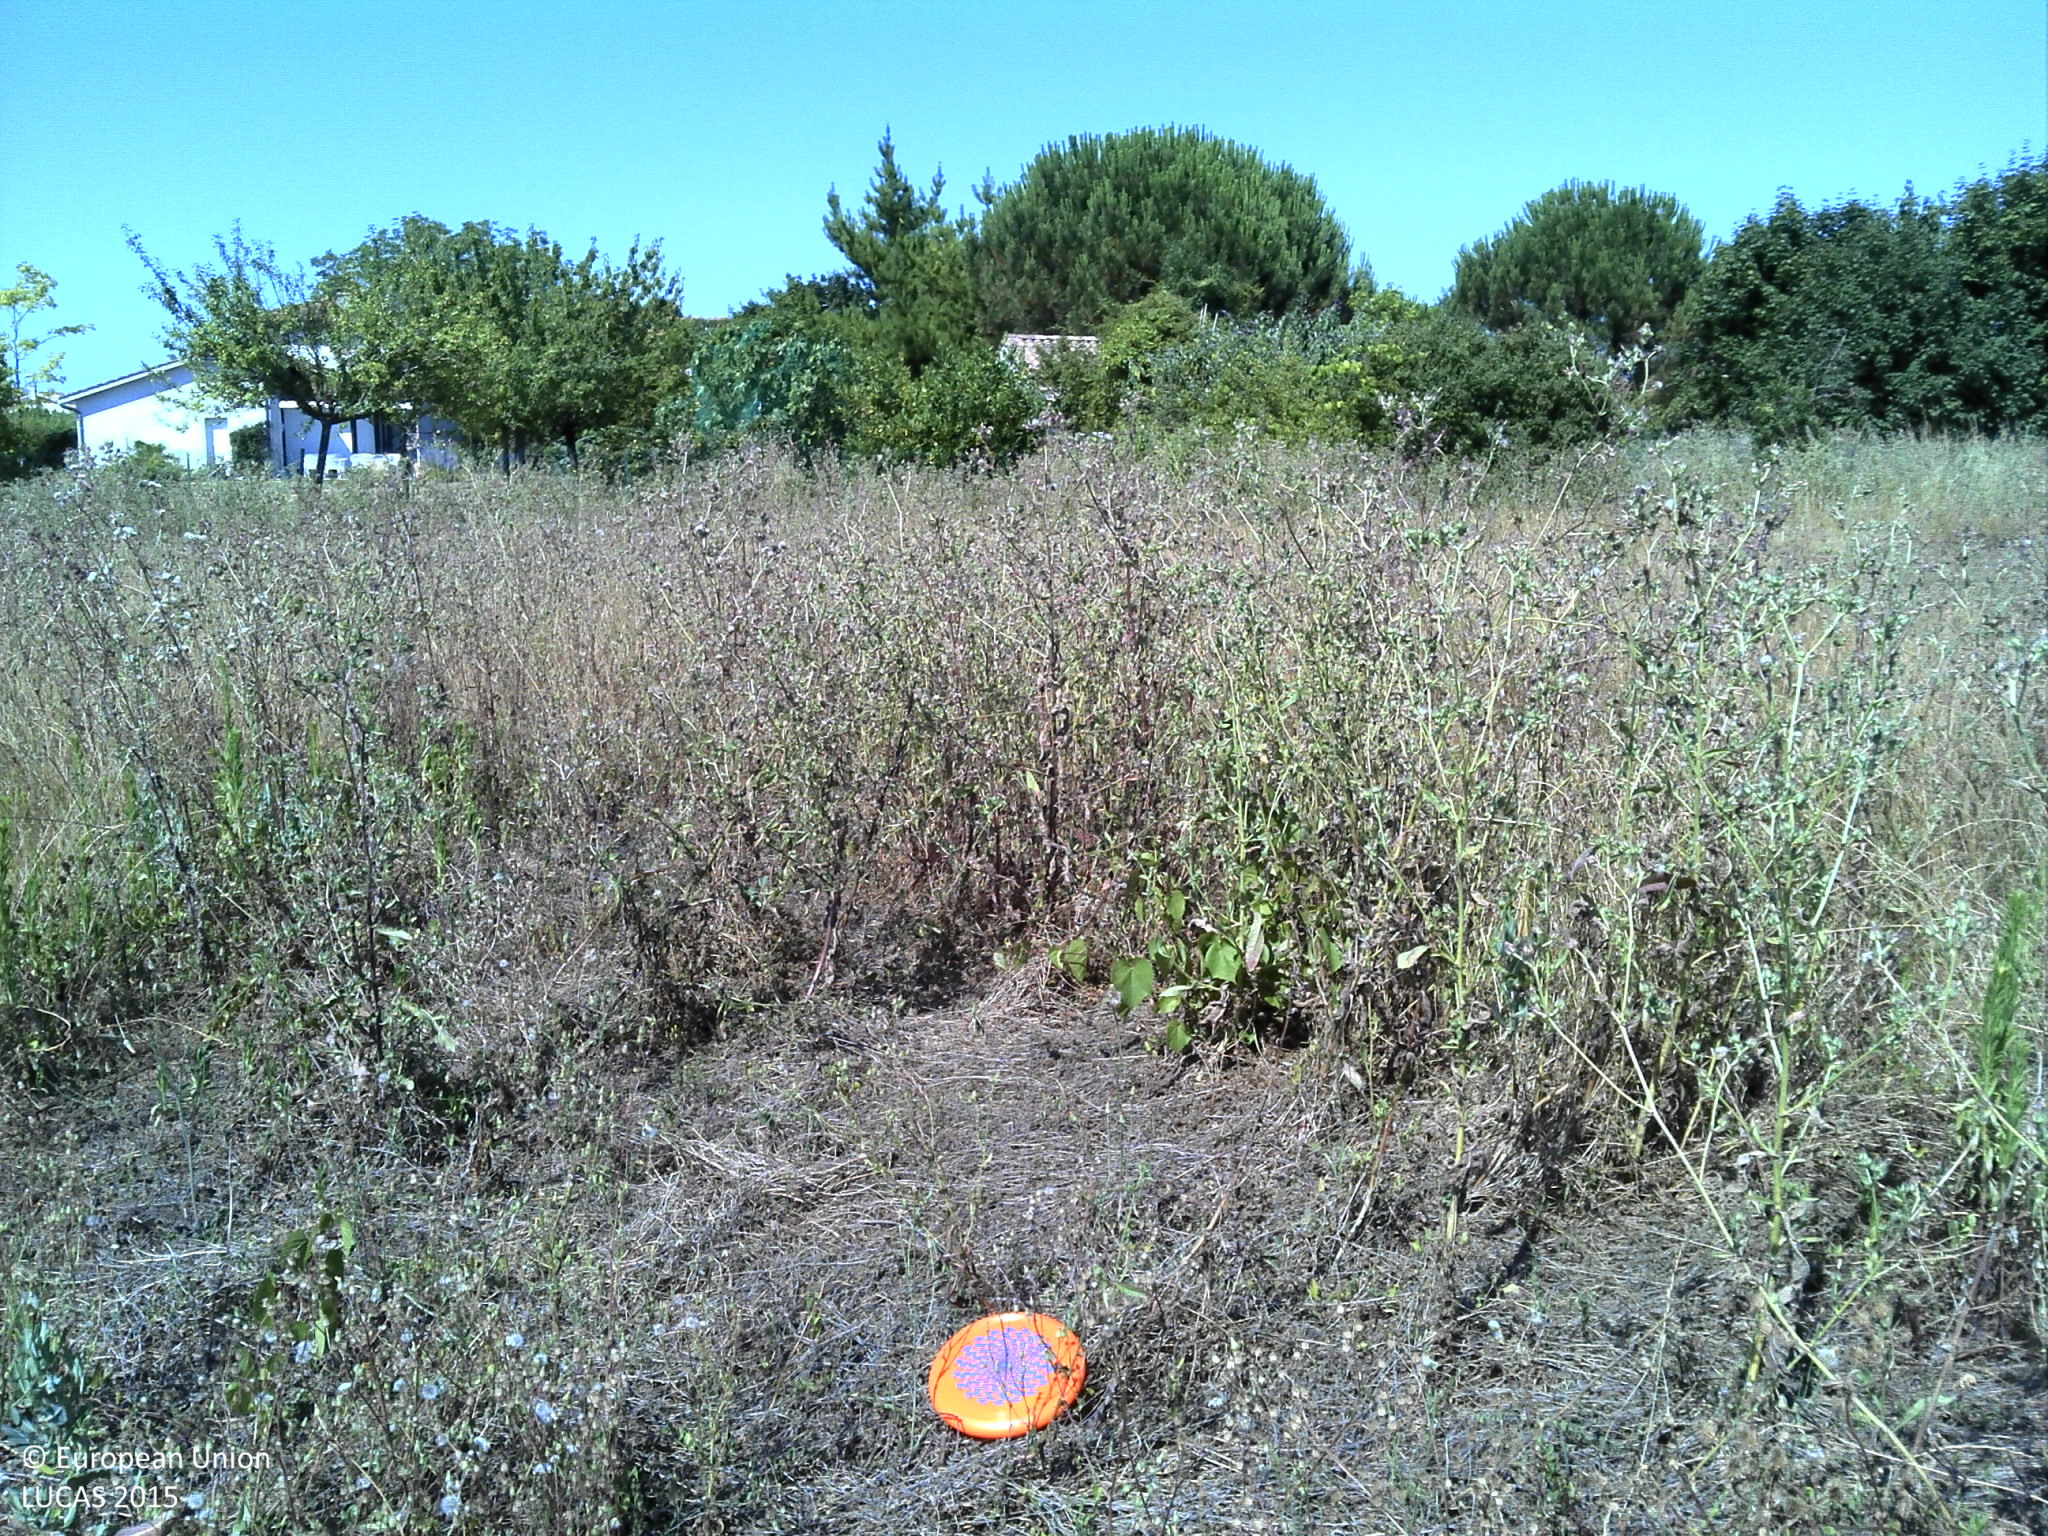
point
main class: Grassland
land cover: Spontaneously vegetated surfaces
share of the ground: > 75 %
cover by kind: herbaceous plants 100 %
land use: Abandoned areas
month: July
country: FR
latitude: 44.9100
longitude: -0.4674
